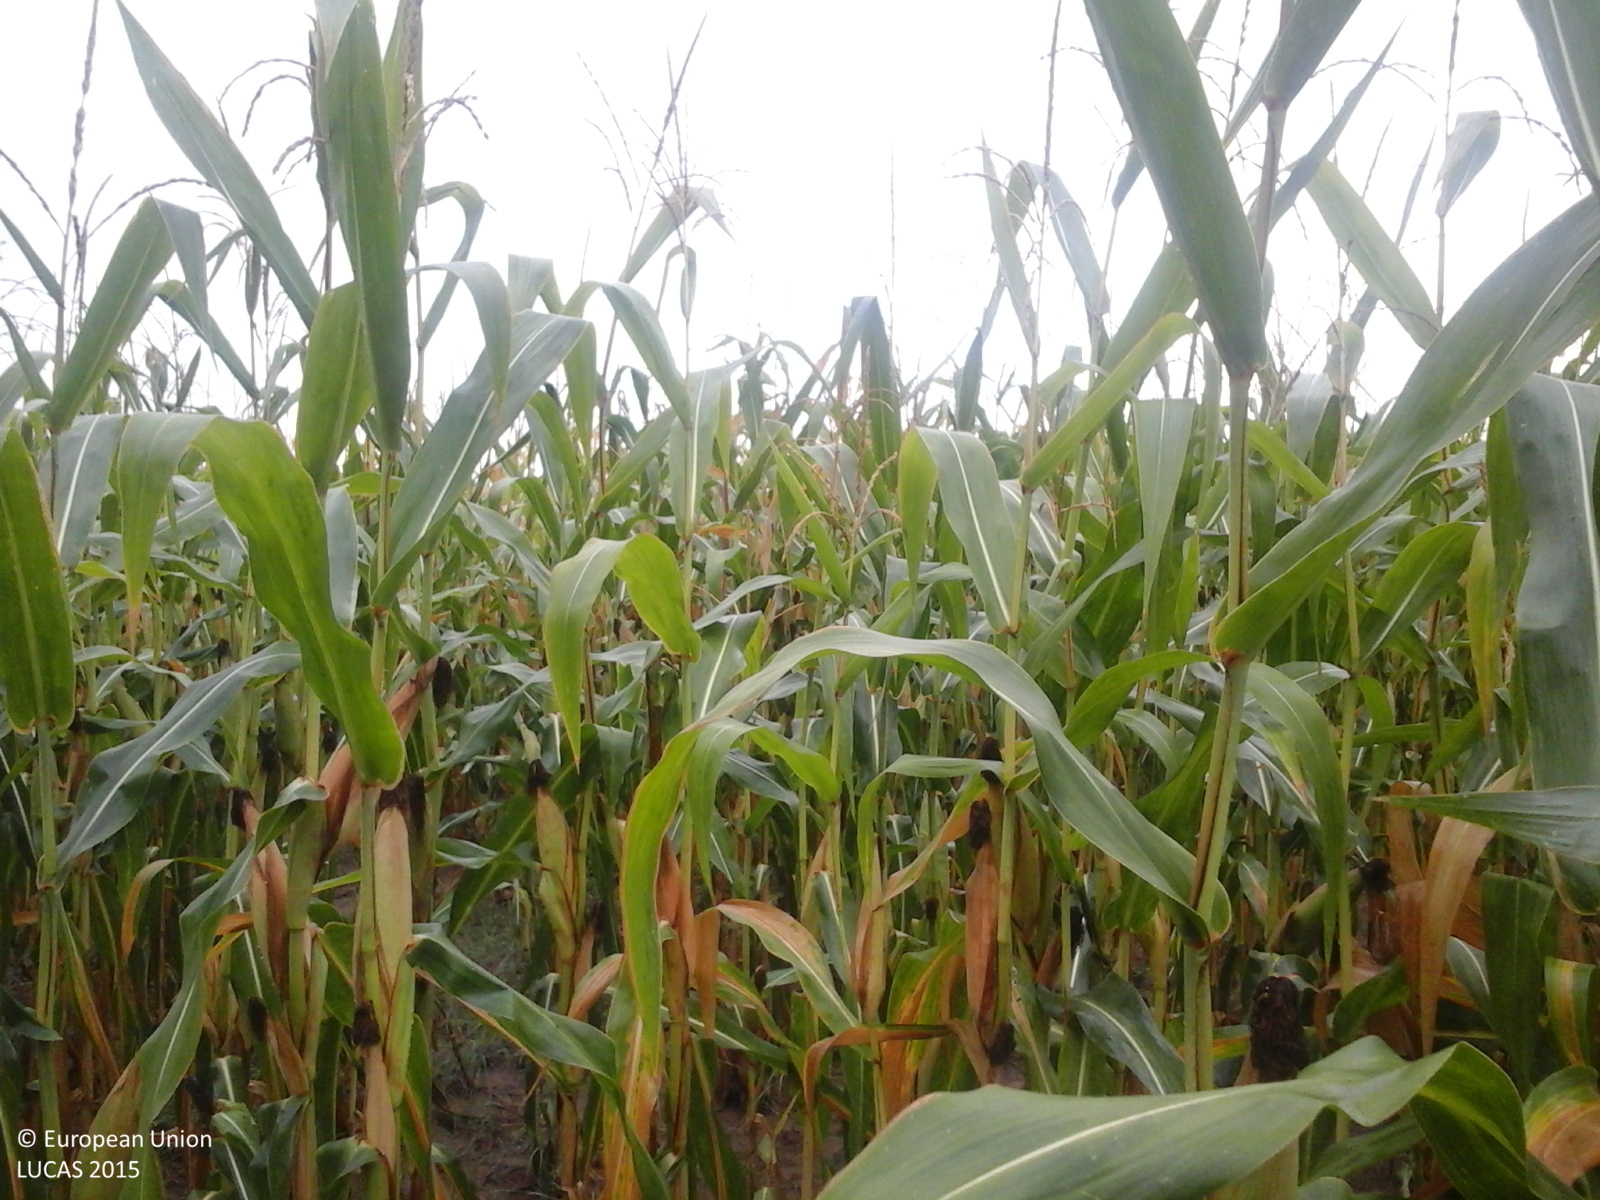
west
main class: Cropland
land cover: Maize
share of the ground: > 75 %
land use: Agriculture (excluding fallow land and kitchen gardens)
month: August
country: RO
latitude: 45.7587
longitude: 21.7232
